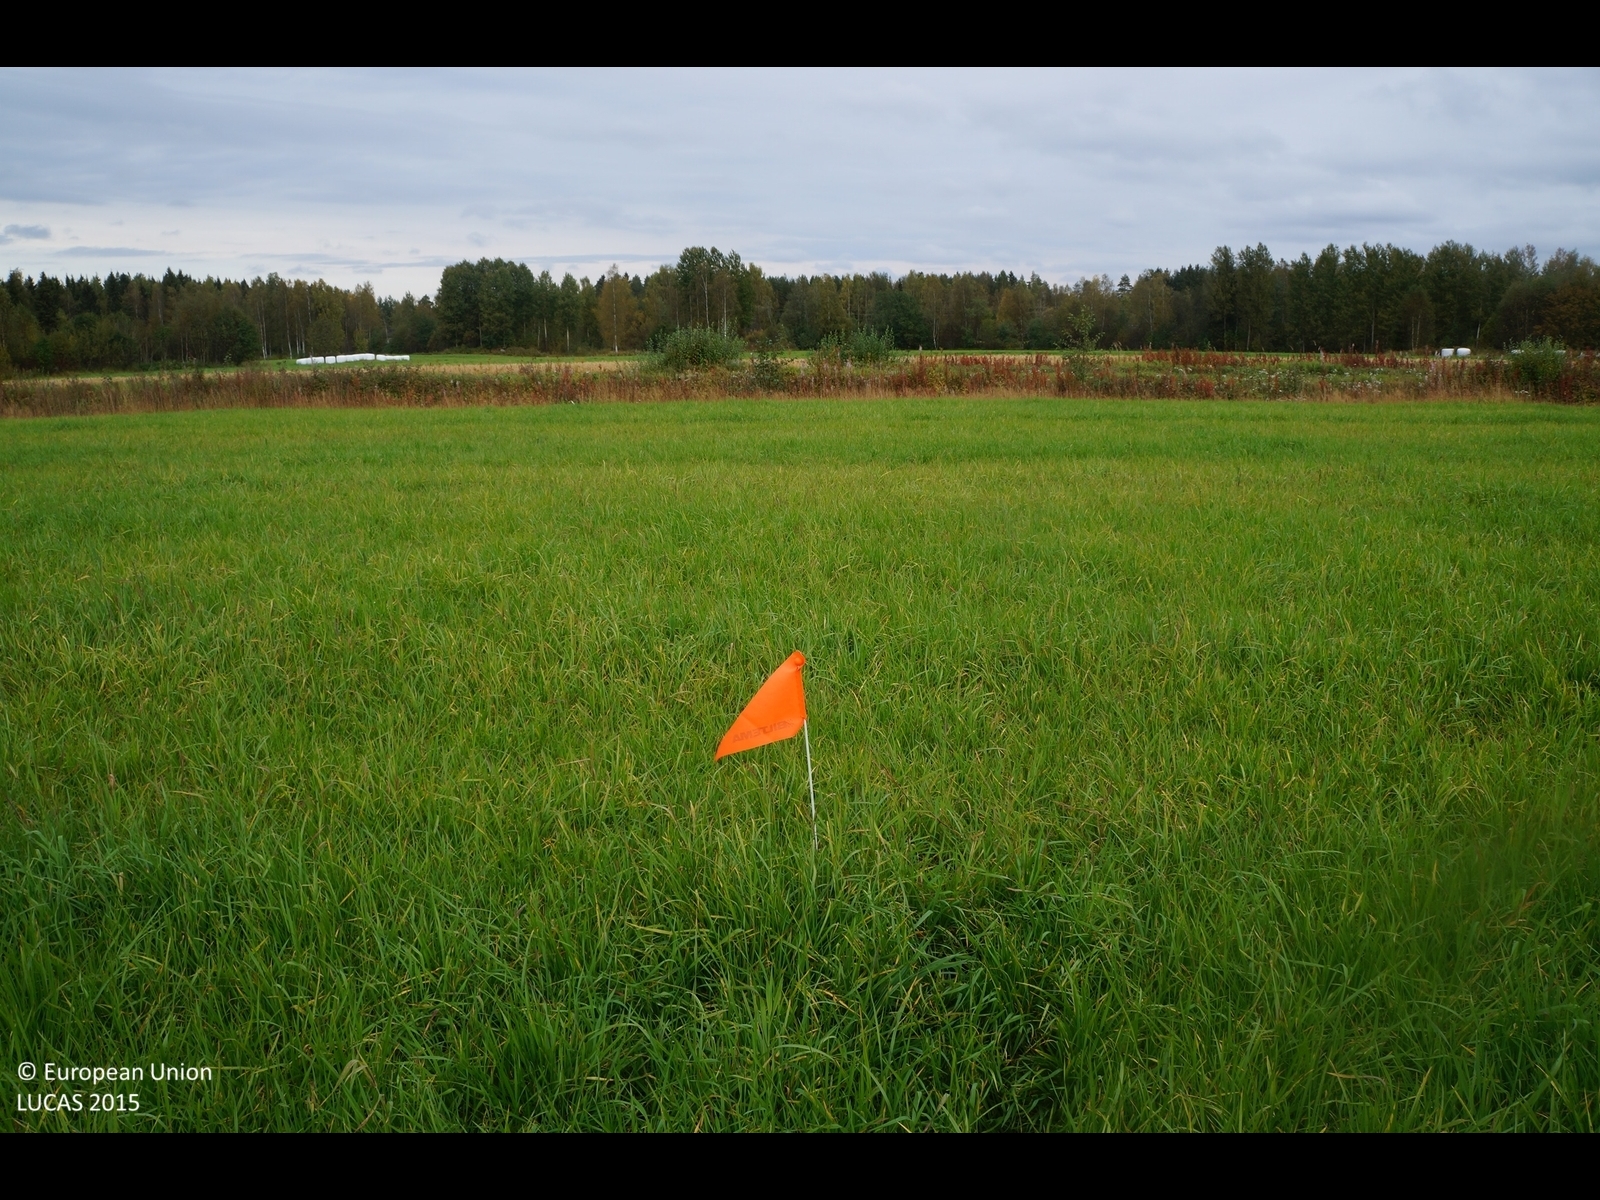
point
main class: Cropland
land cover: Temporary grasslands
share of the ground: > 75 %
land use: Agriculture (excluding fallow land and kitchen gardens)
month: September
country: FI
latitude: 63.9993
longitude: 23.7388
